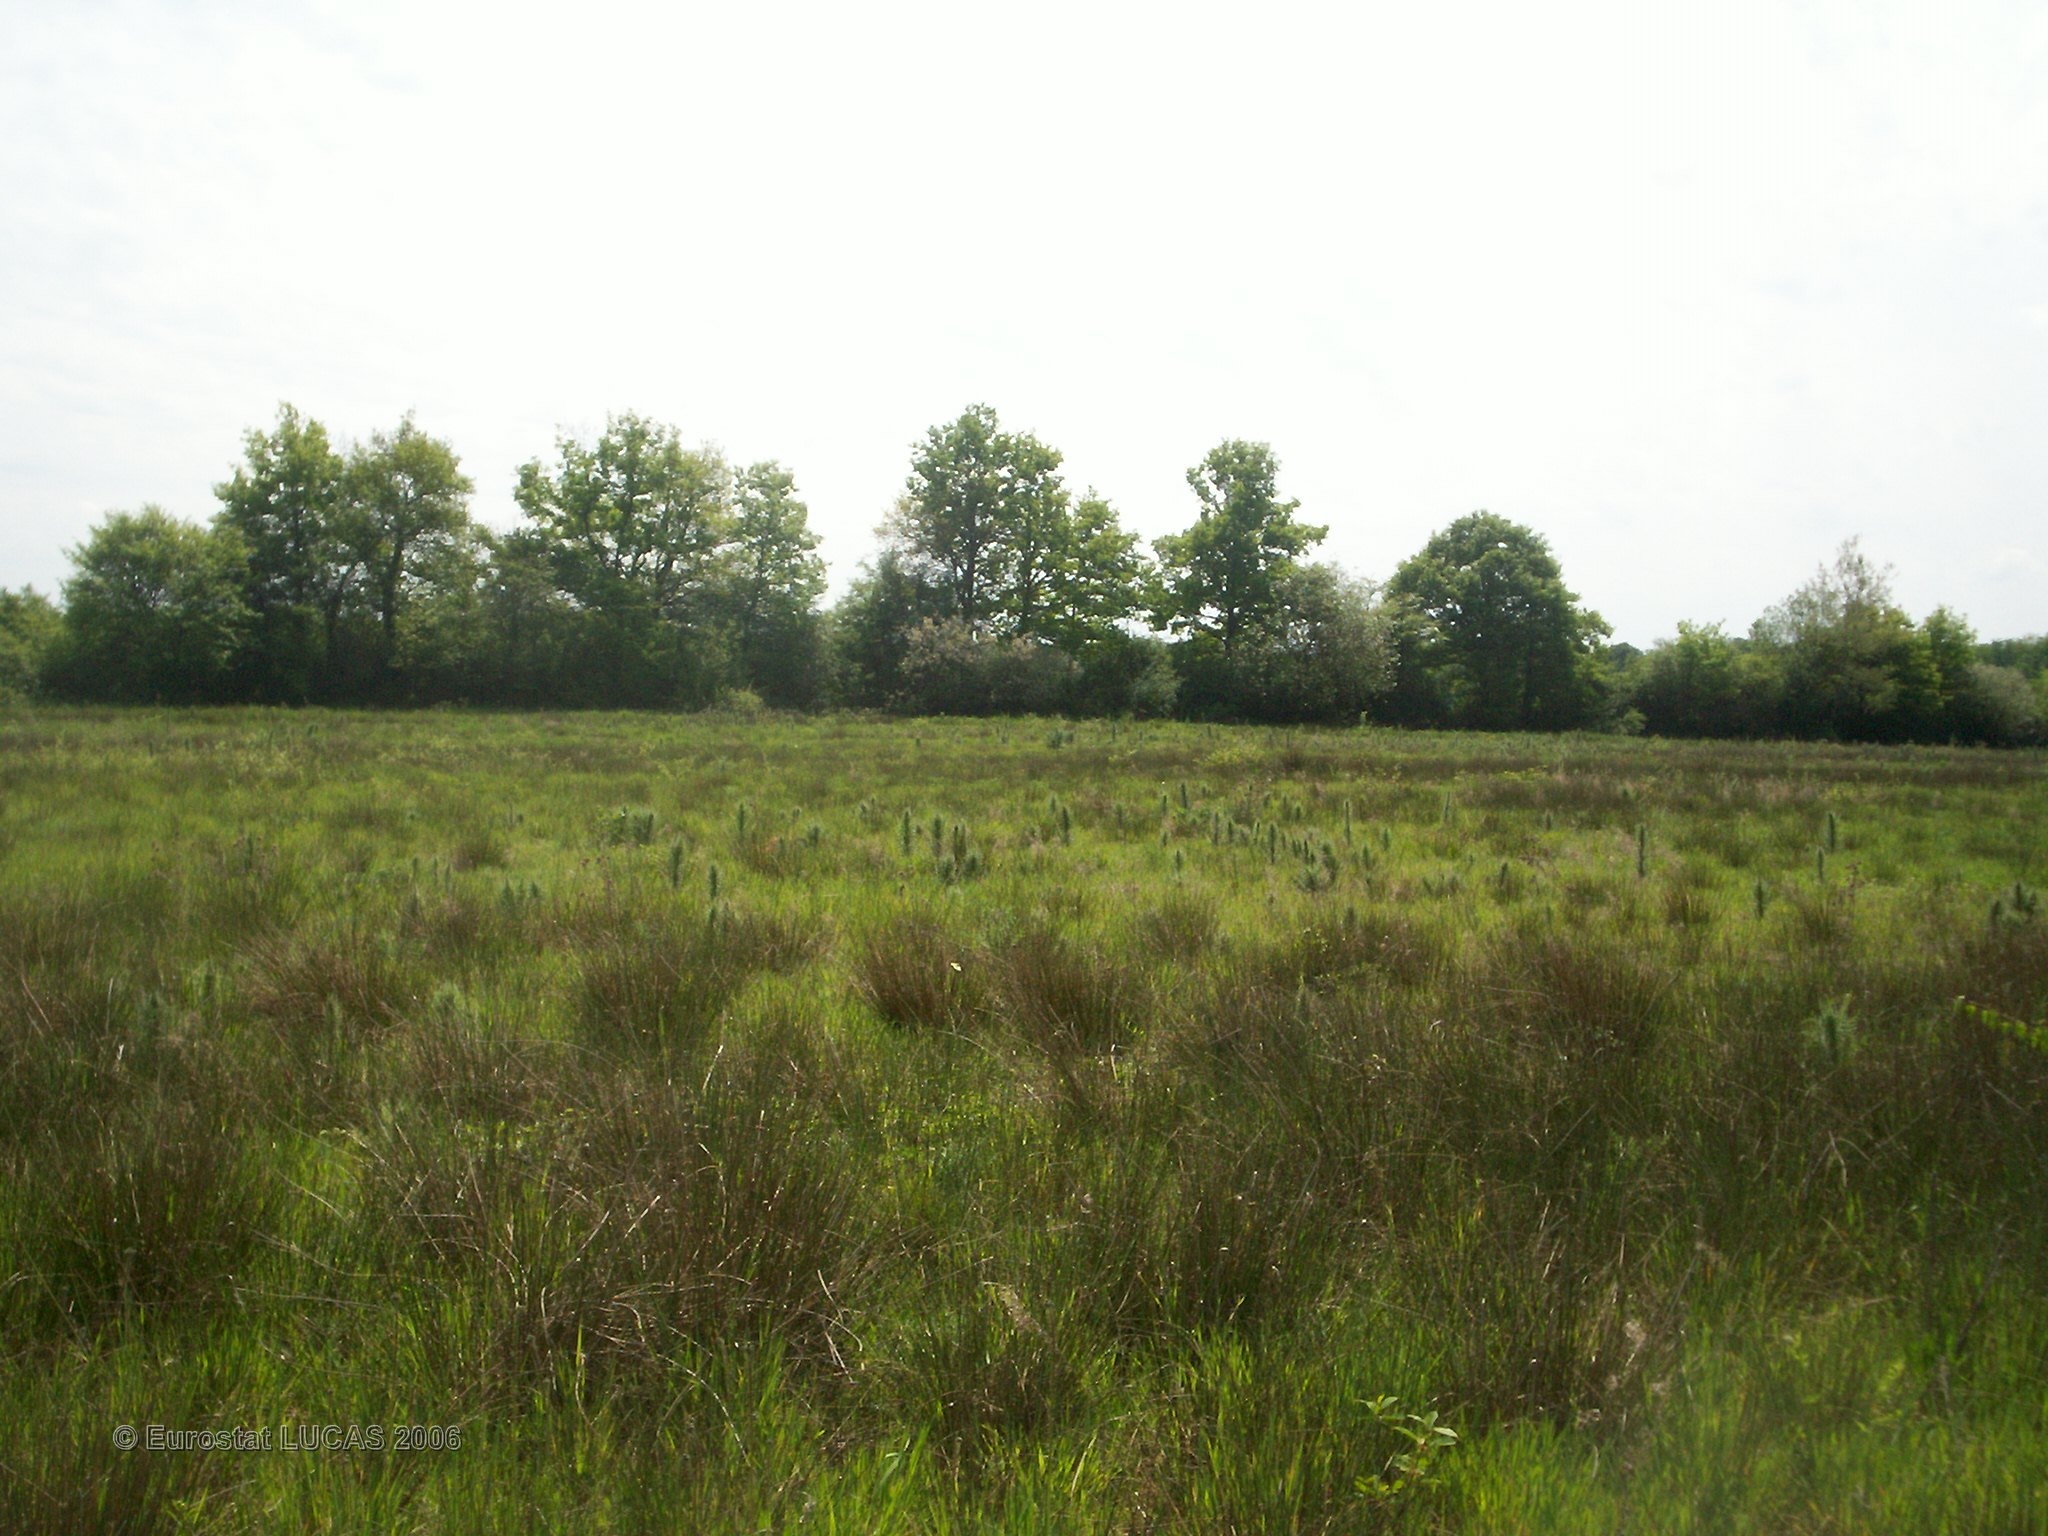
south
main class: Grassland
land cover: Grassland without tree/shrub cover
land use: Agriculture (excluding fallow land and kitchen gardens)
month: May
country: FR
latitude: 47.6384
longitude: 2.9794
